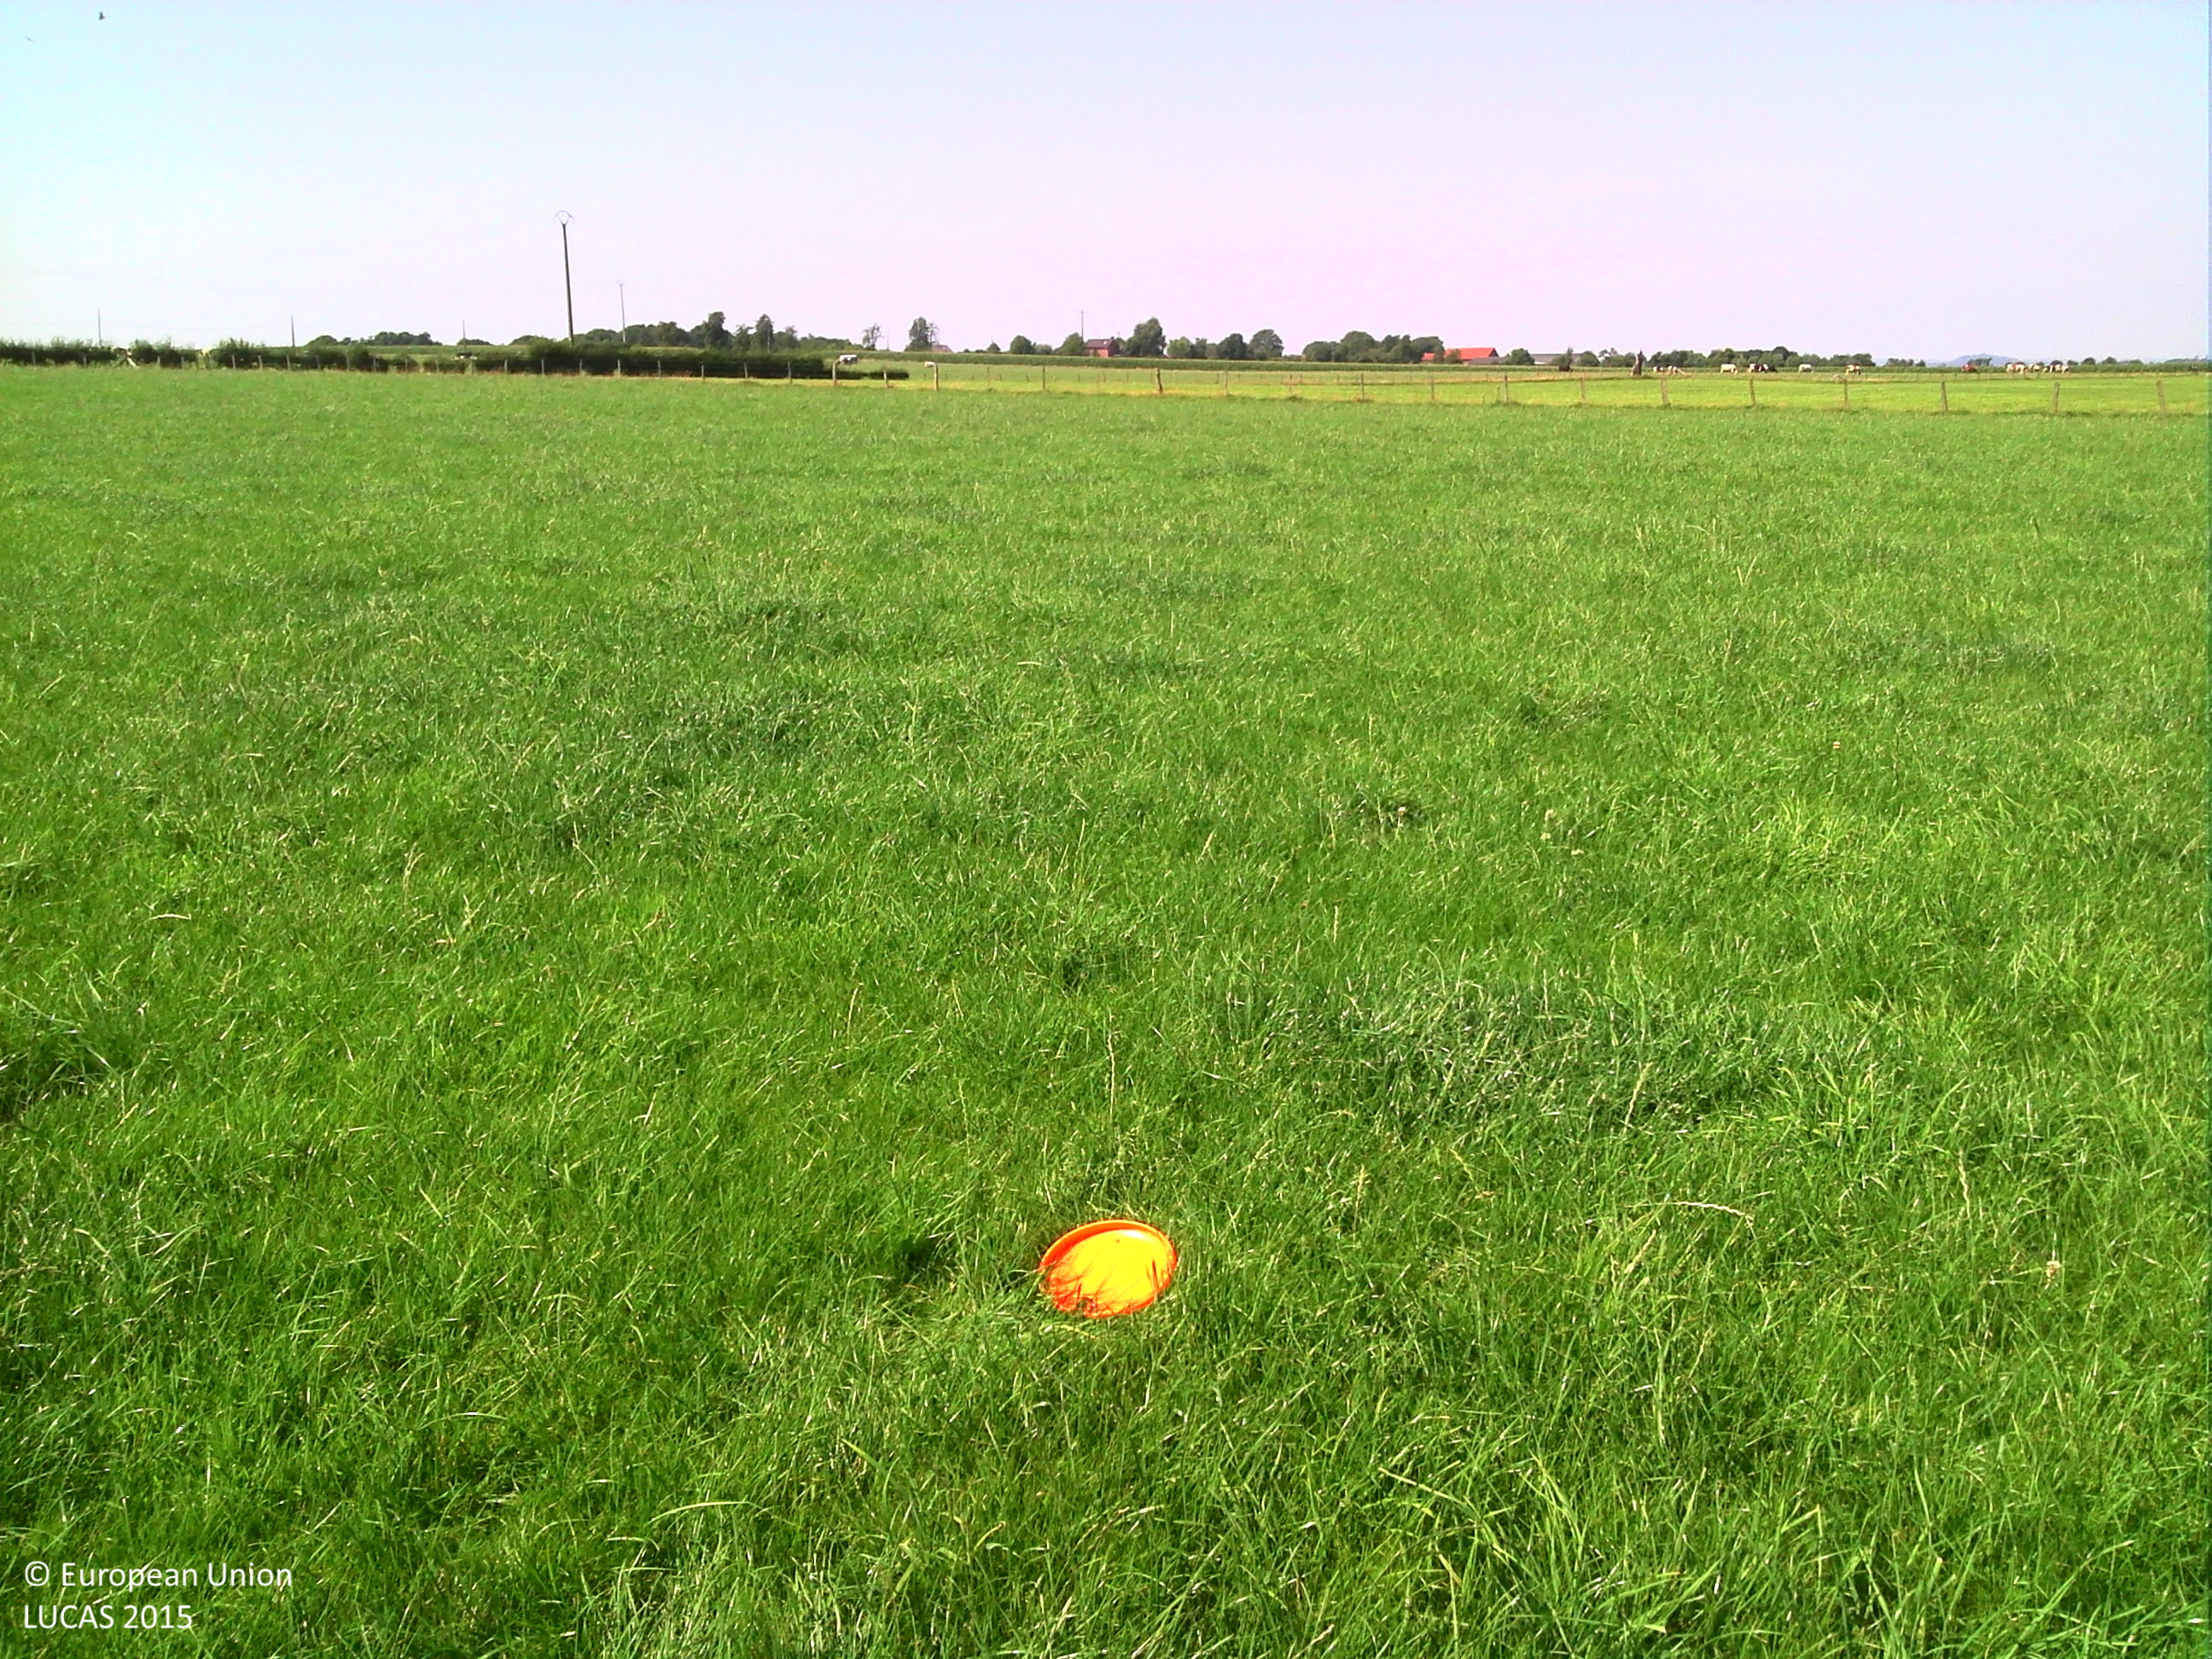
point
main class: Cropland
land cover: Temporary grasslands
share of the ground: > 75 %
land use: Agriculture (excluding fallow land and kitchen gardens)
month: August
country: BE
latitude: 50.7567
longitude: 5.8453
